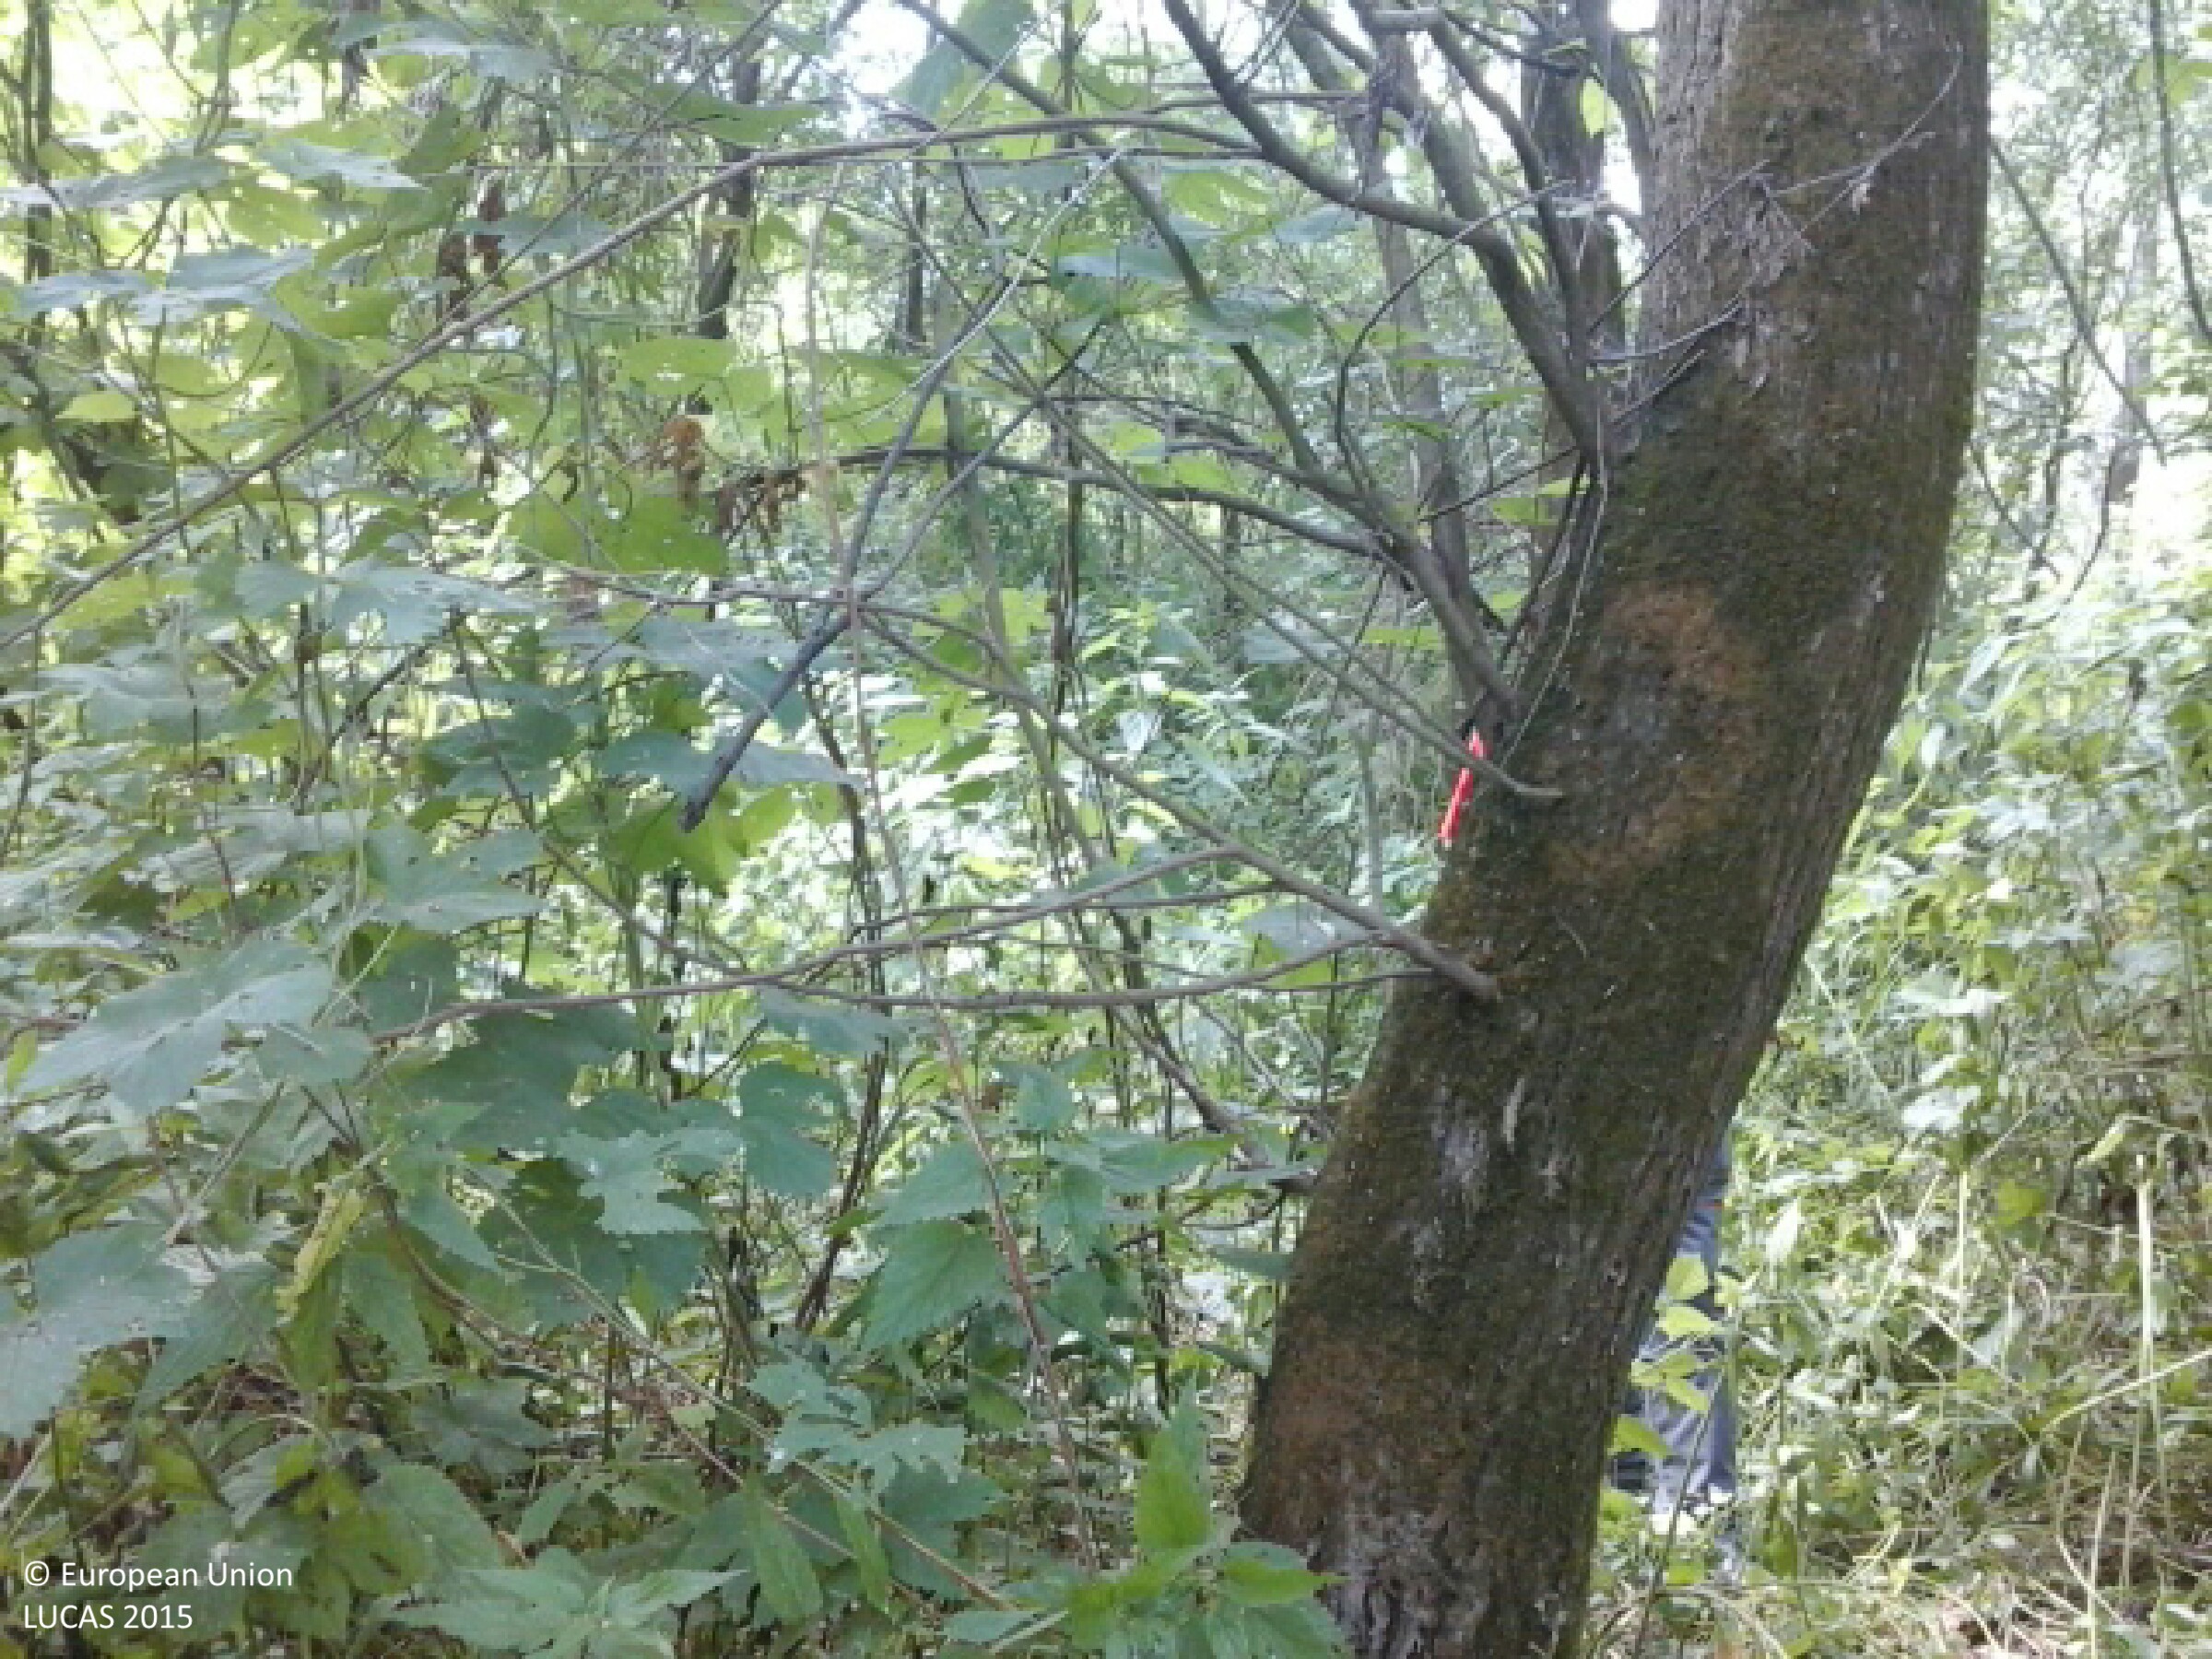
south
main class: Woodland
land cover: Broadleaved woodland
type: floodplain forest
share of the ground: > 75 %
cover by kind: broadleaved forest trees 100 %
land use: Forestry
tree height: > 5 m
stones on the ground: < 10 %
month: July
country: HU
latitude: 48.3067
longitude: 22.0399
